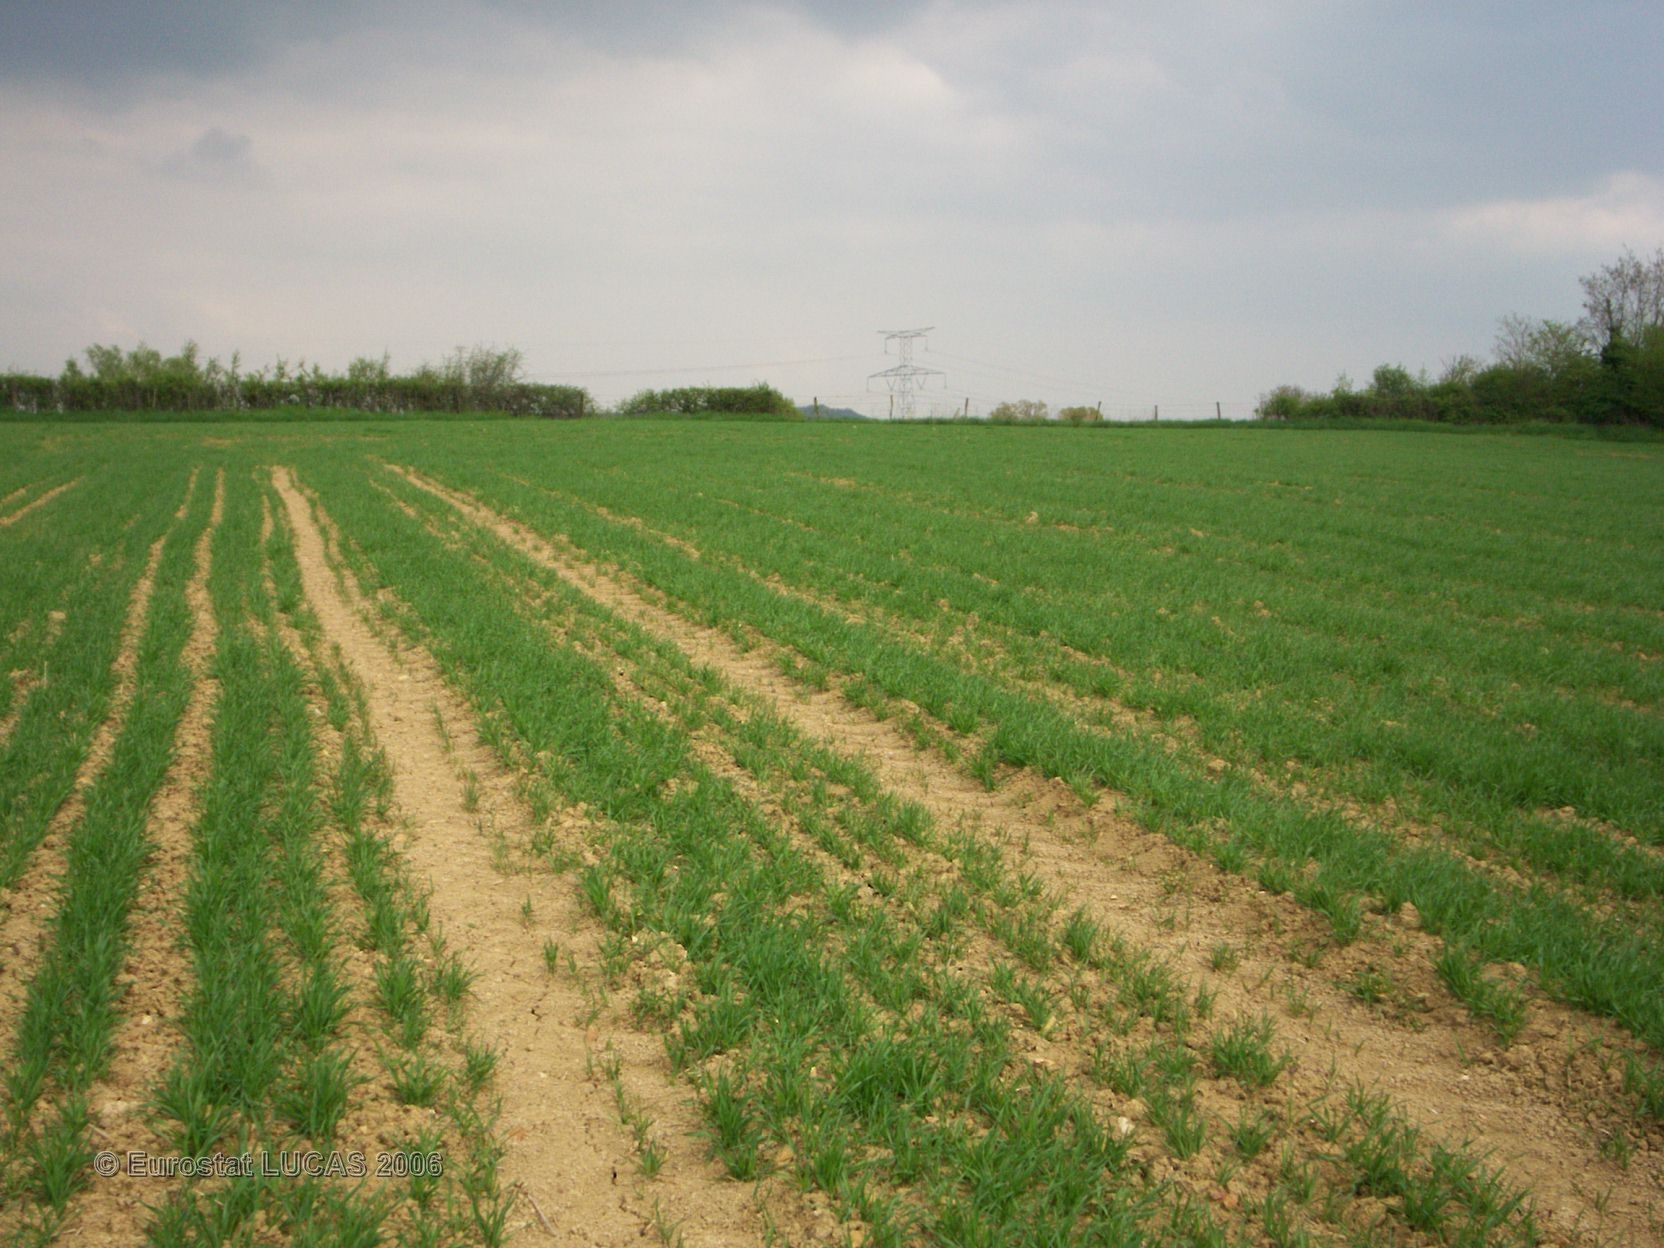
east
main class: Cropland
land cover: Barley
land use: Agriculture (excluding fallow land and kitchen gardens)
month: April
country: FR
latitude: 47.1027
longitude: 3.0781
